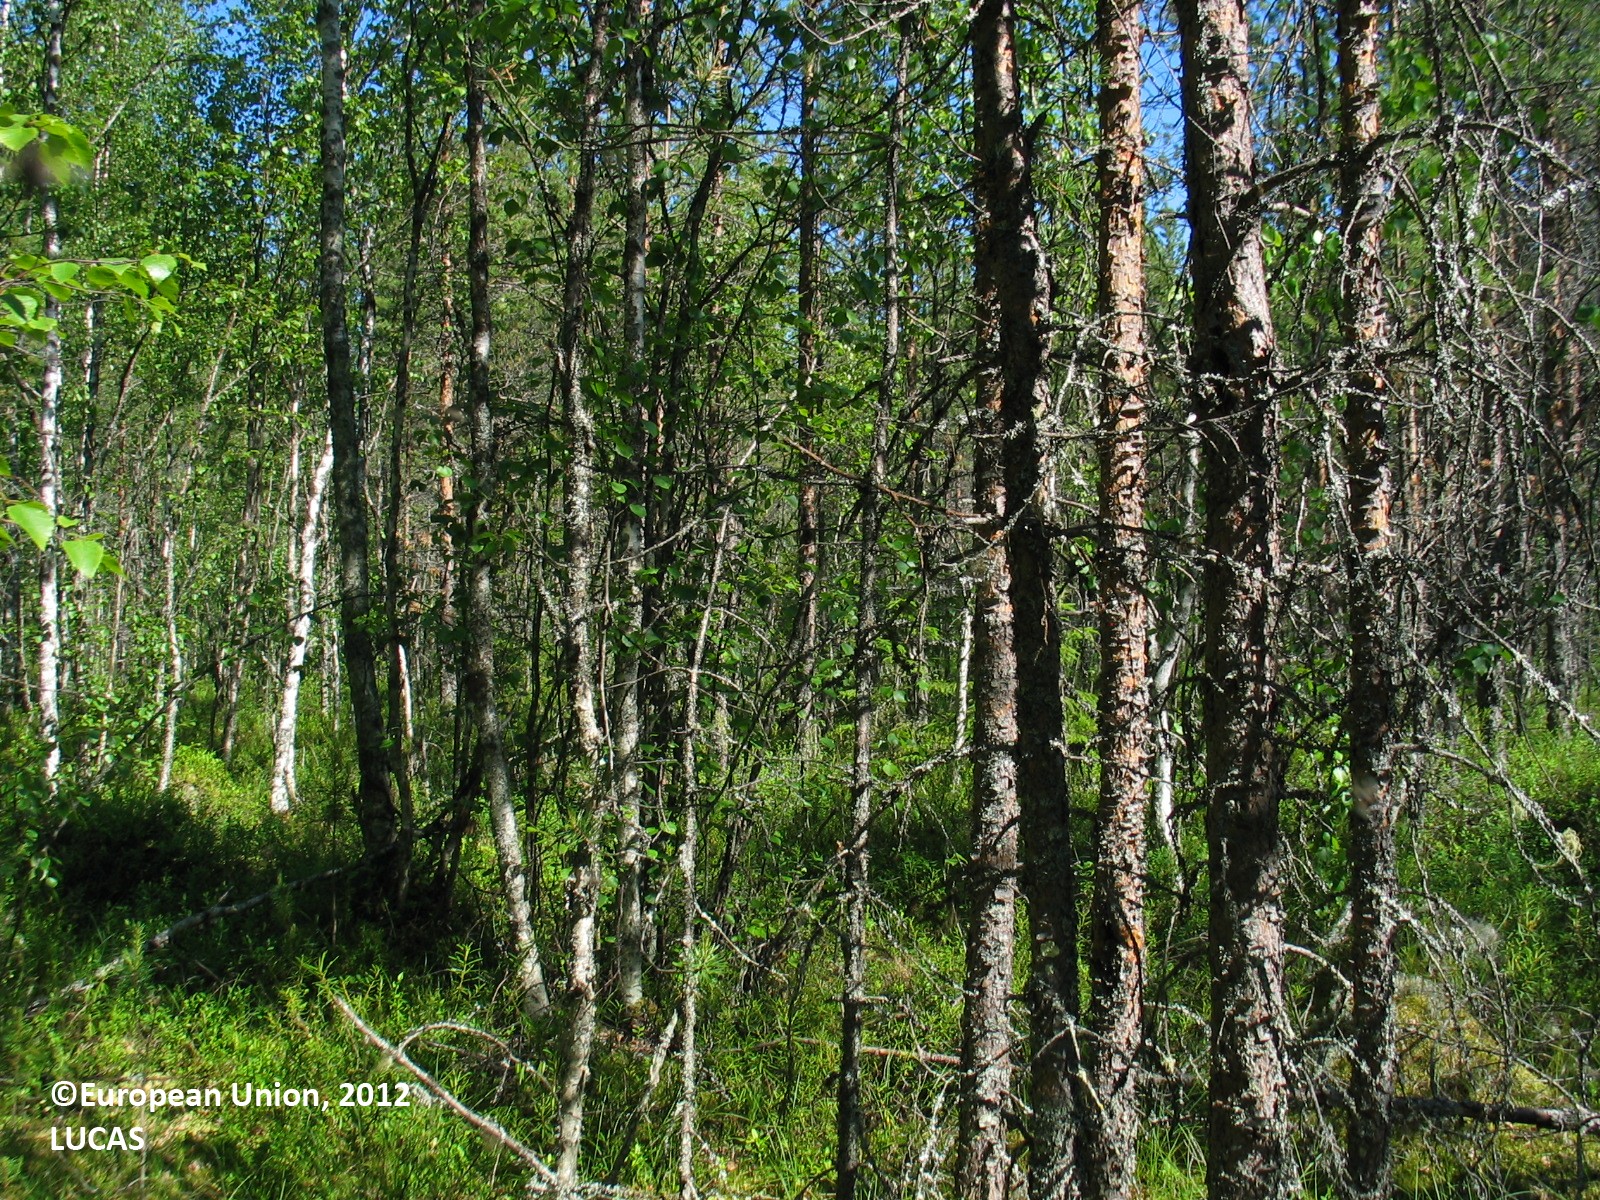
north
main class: Woodland
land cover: Other mixed woodland
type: boreal forest
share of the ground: 50 - 75 %
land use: Forestry
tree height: > 5 m
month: July
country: FI
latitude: 64.4372
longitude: 26.2904
